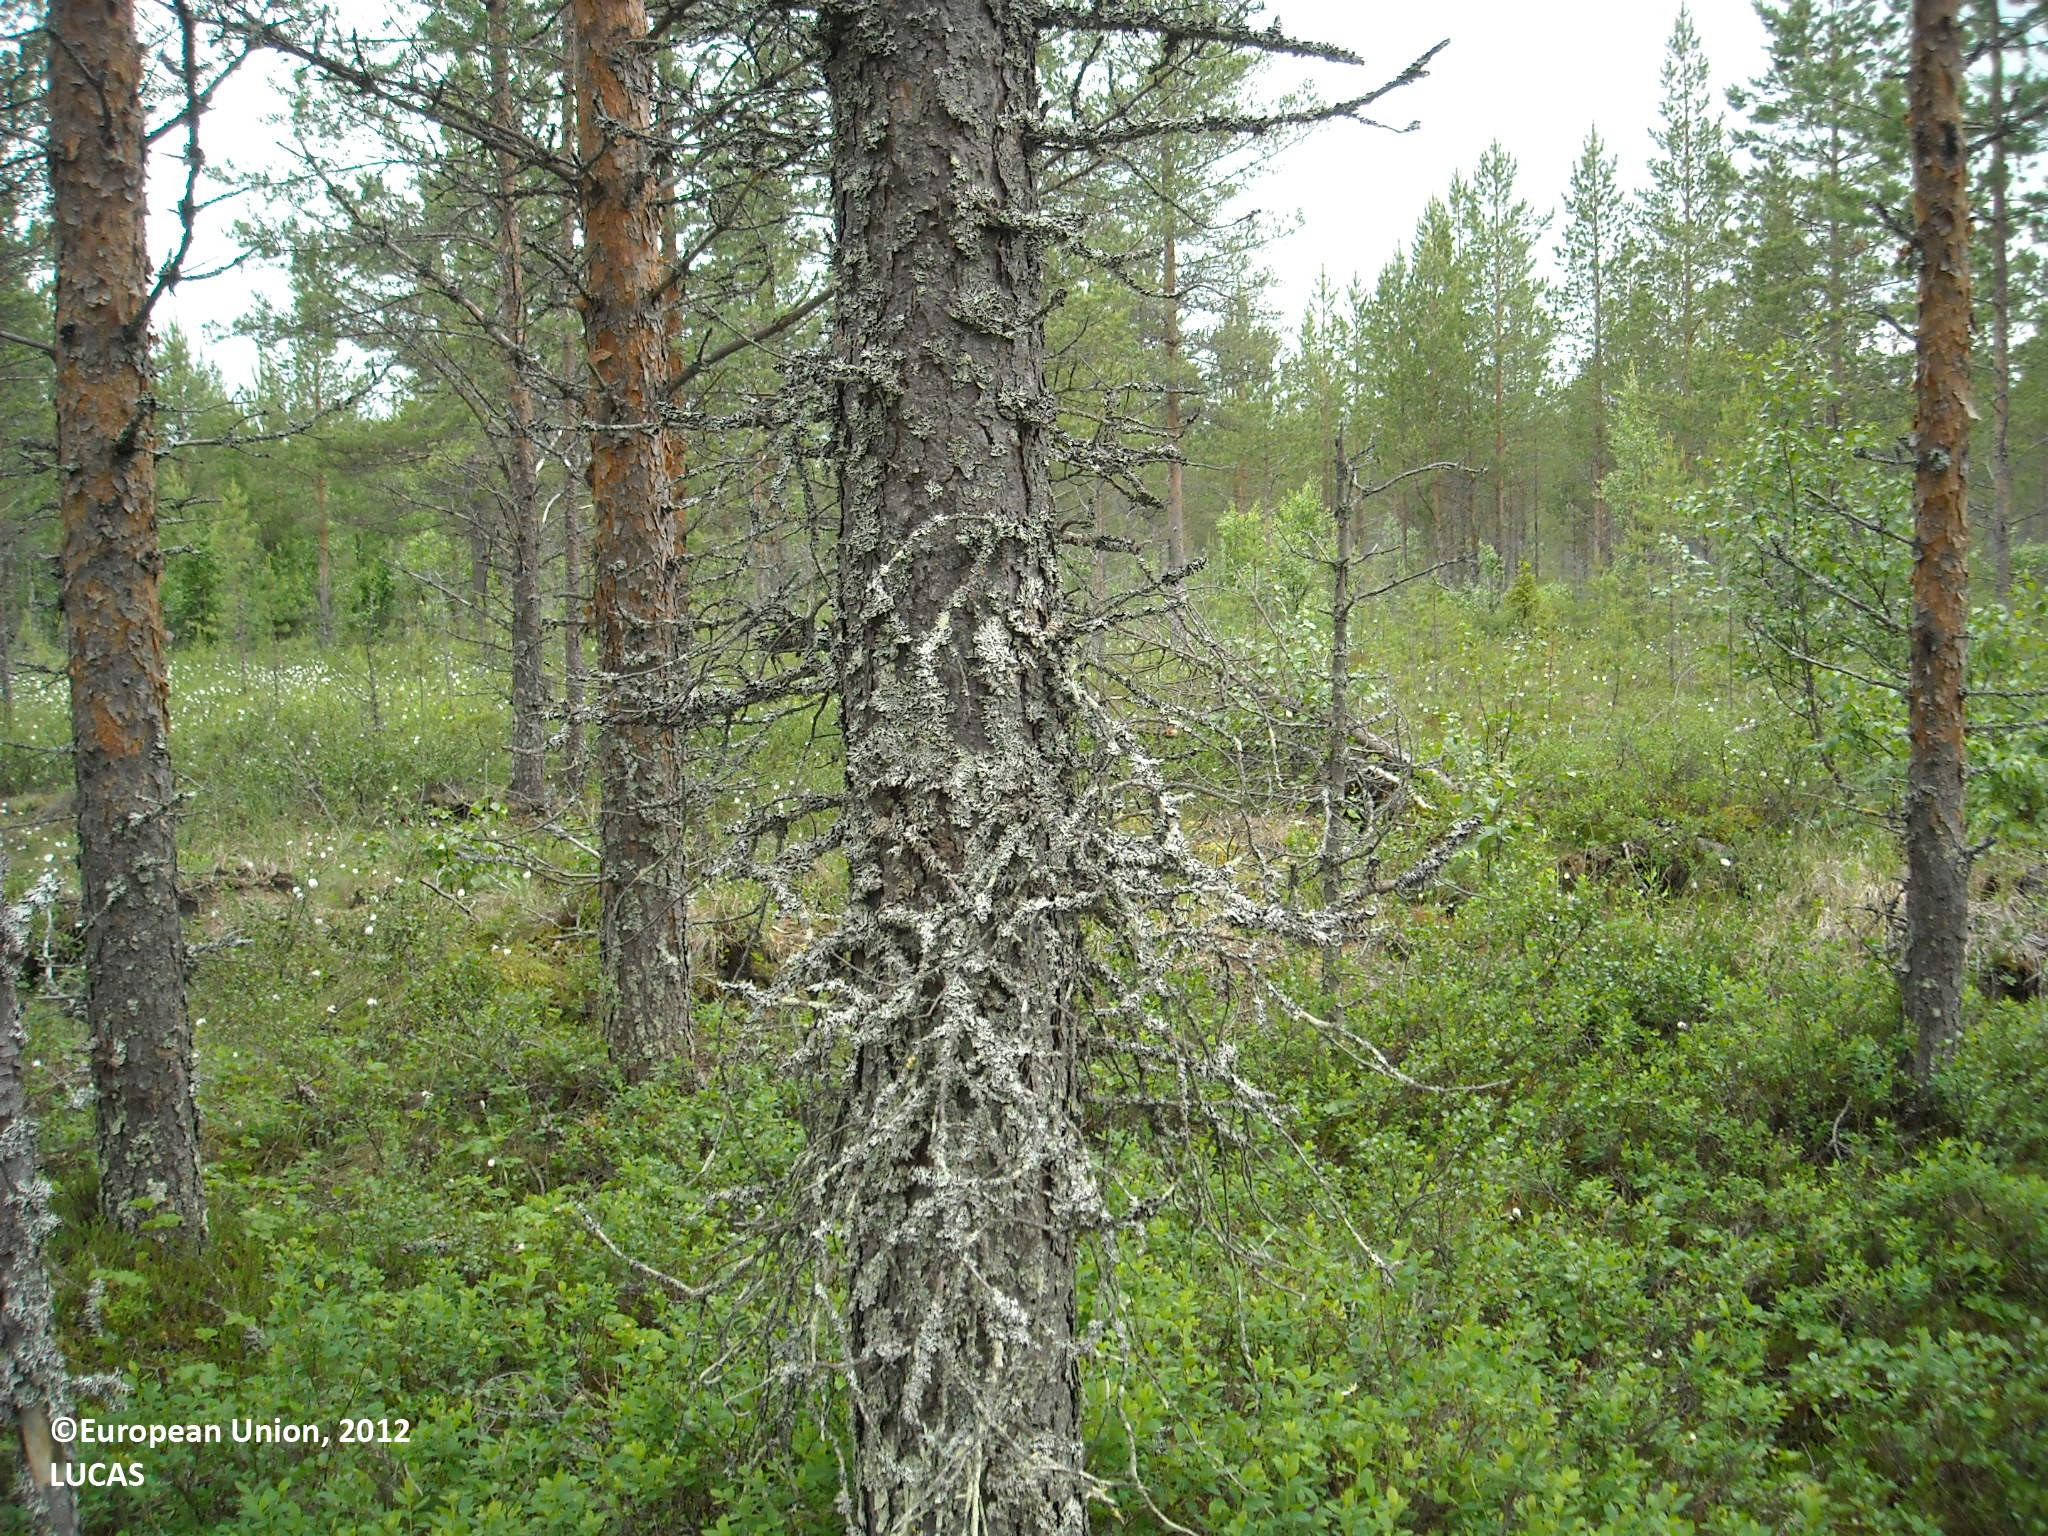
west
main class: Woodland
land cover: Pine dominated coniferous woodland
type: mire and swamp forests
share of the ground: 50 - 75 %
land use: Forestry
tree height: > 5 m
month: June
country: FI
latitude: 64.8435
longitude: 27.3594
